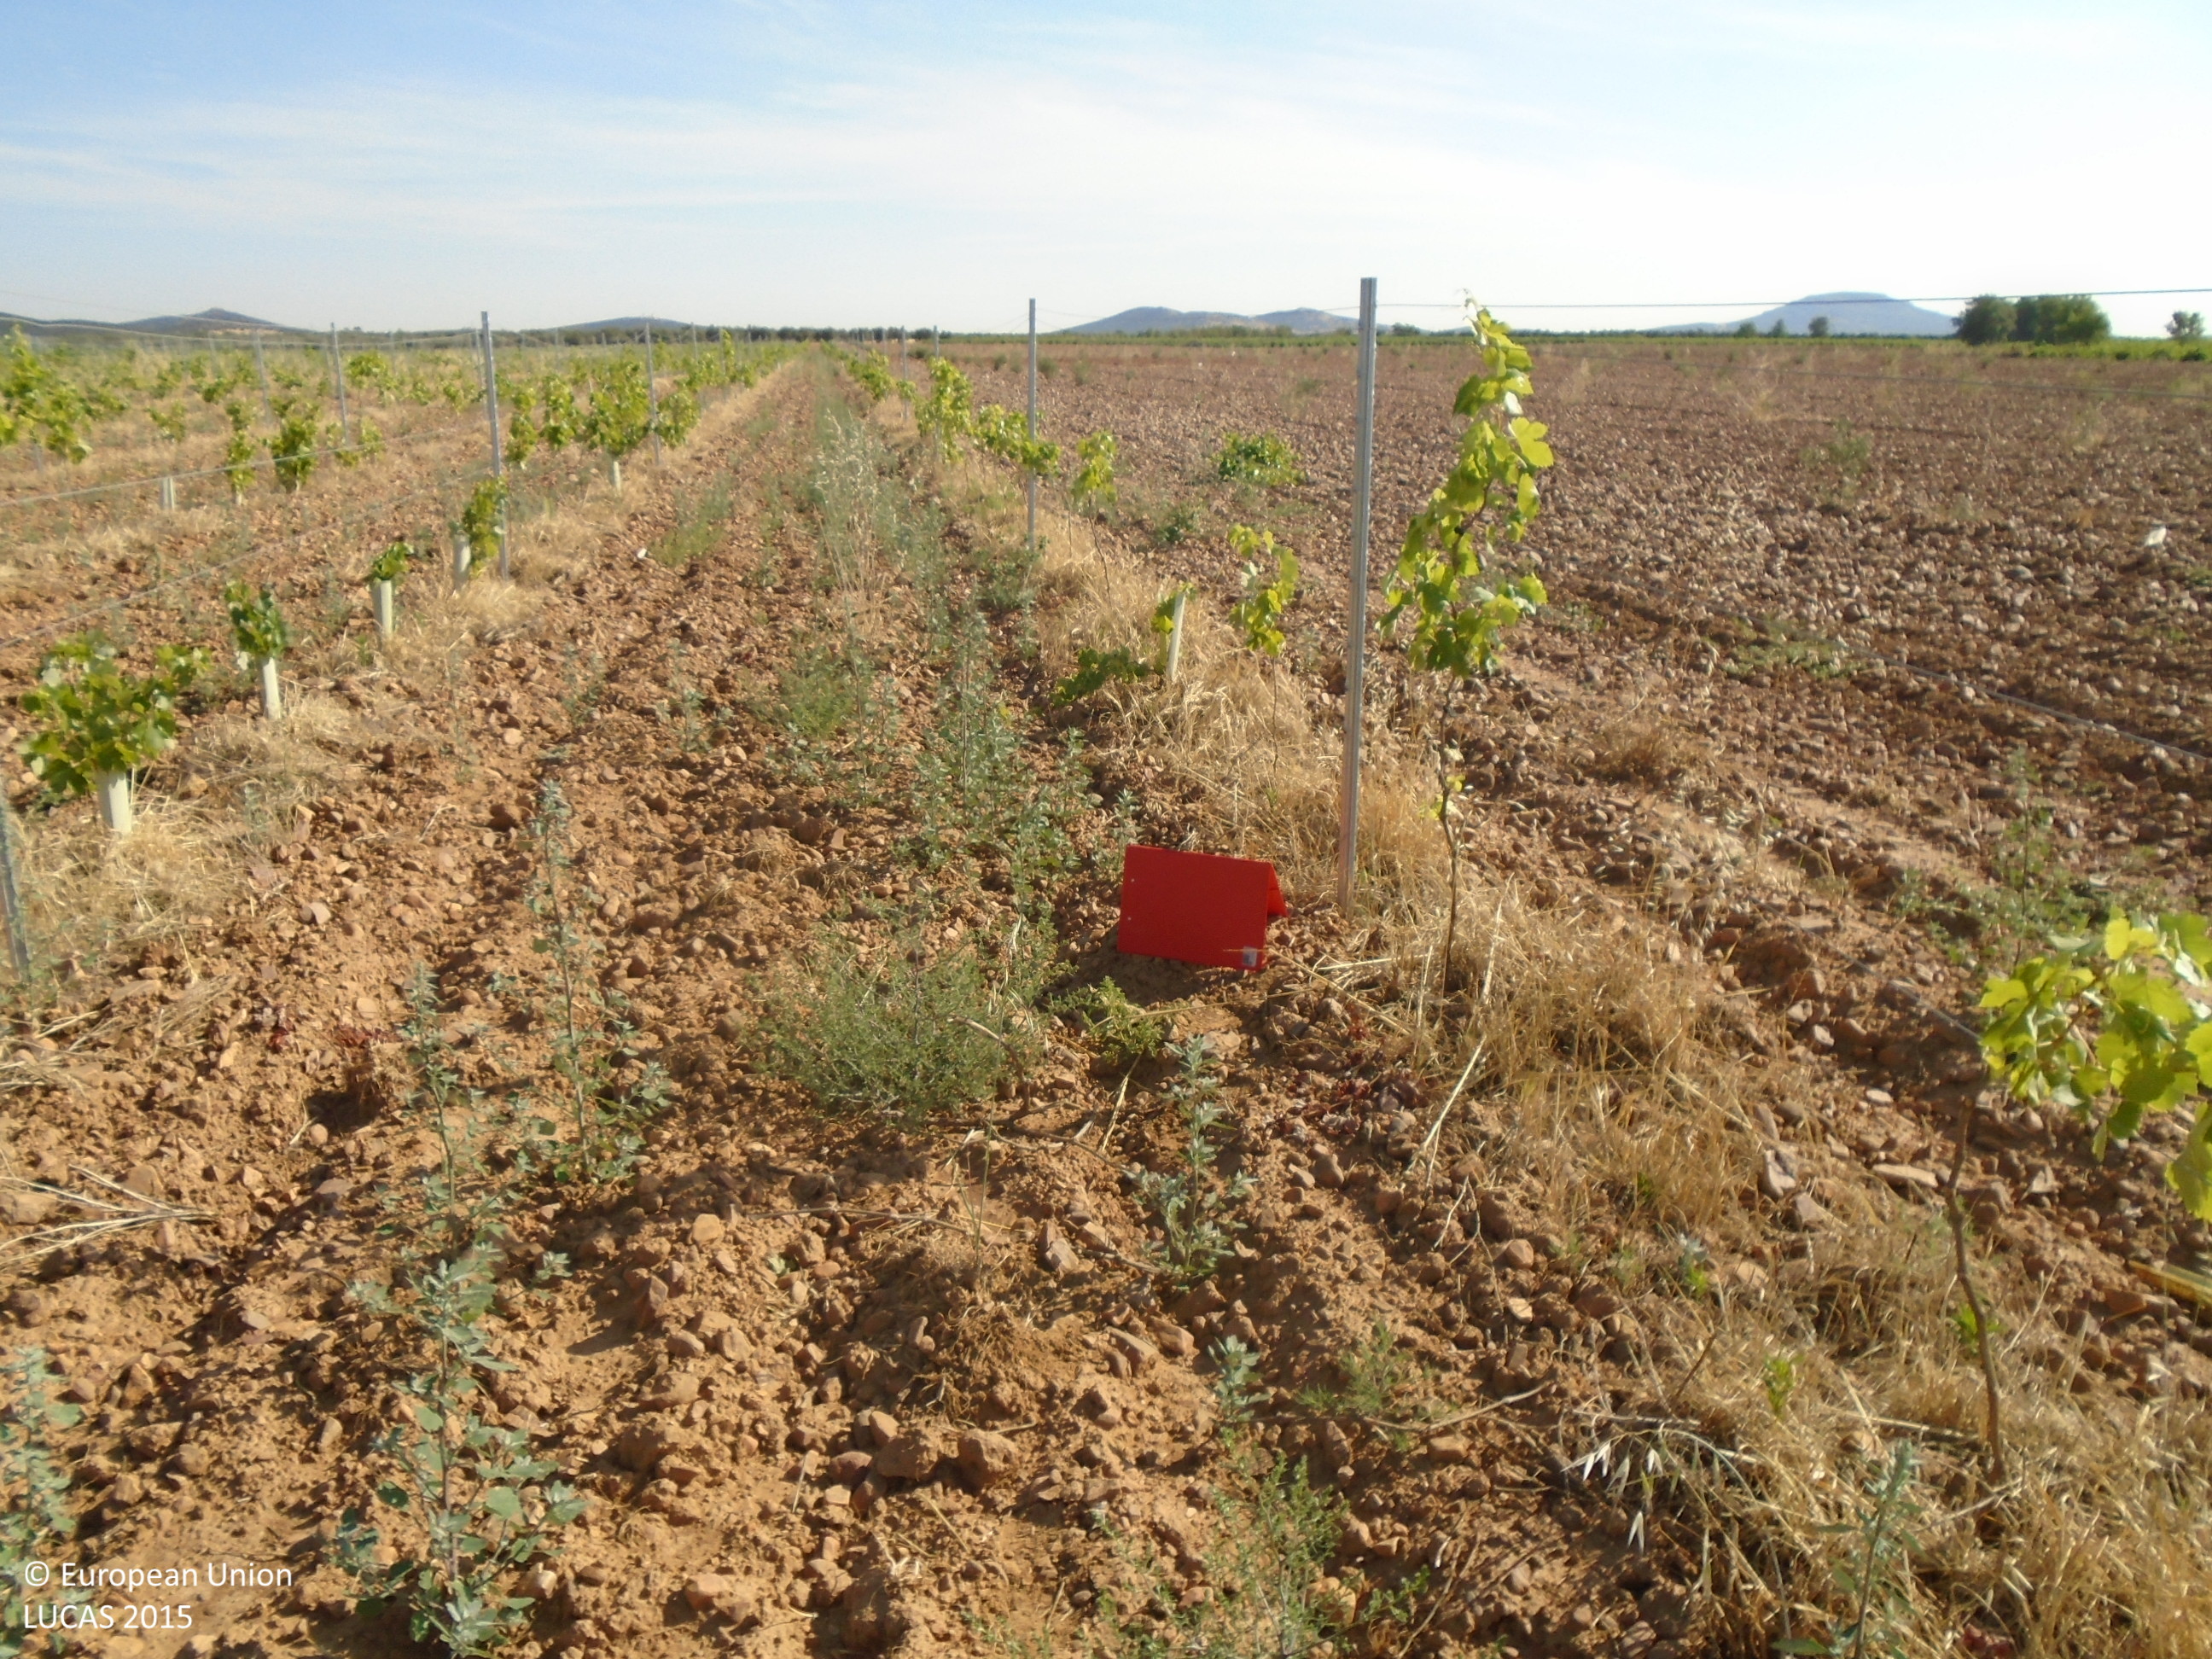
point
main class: Cropland
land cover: Vineyards
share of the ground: < 10 %
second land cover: Other bare soil
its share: > 75 %
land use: Agriculture (excluding fallow land and kitchen gardens)
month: June
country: ES
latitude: 39.2745
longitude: -3.5006
